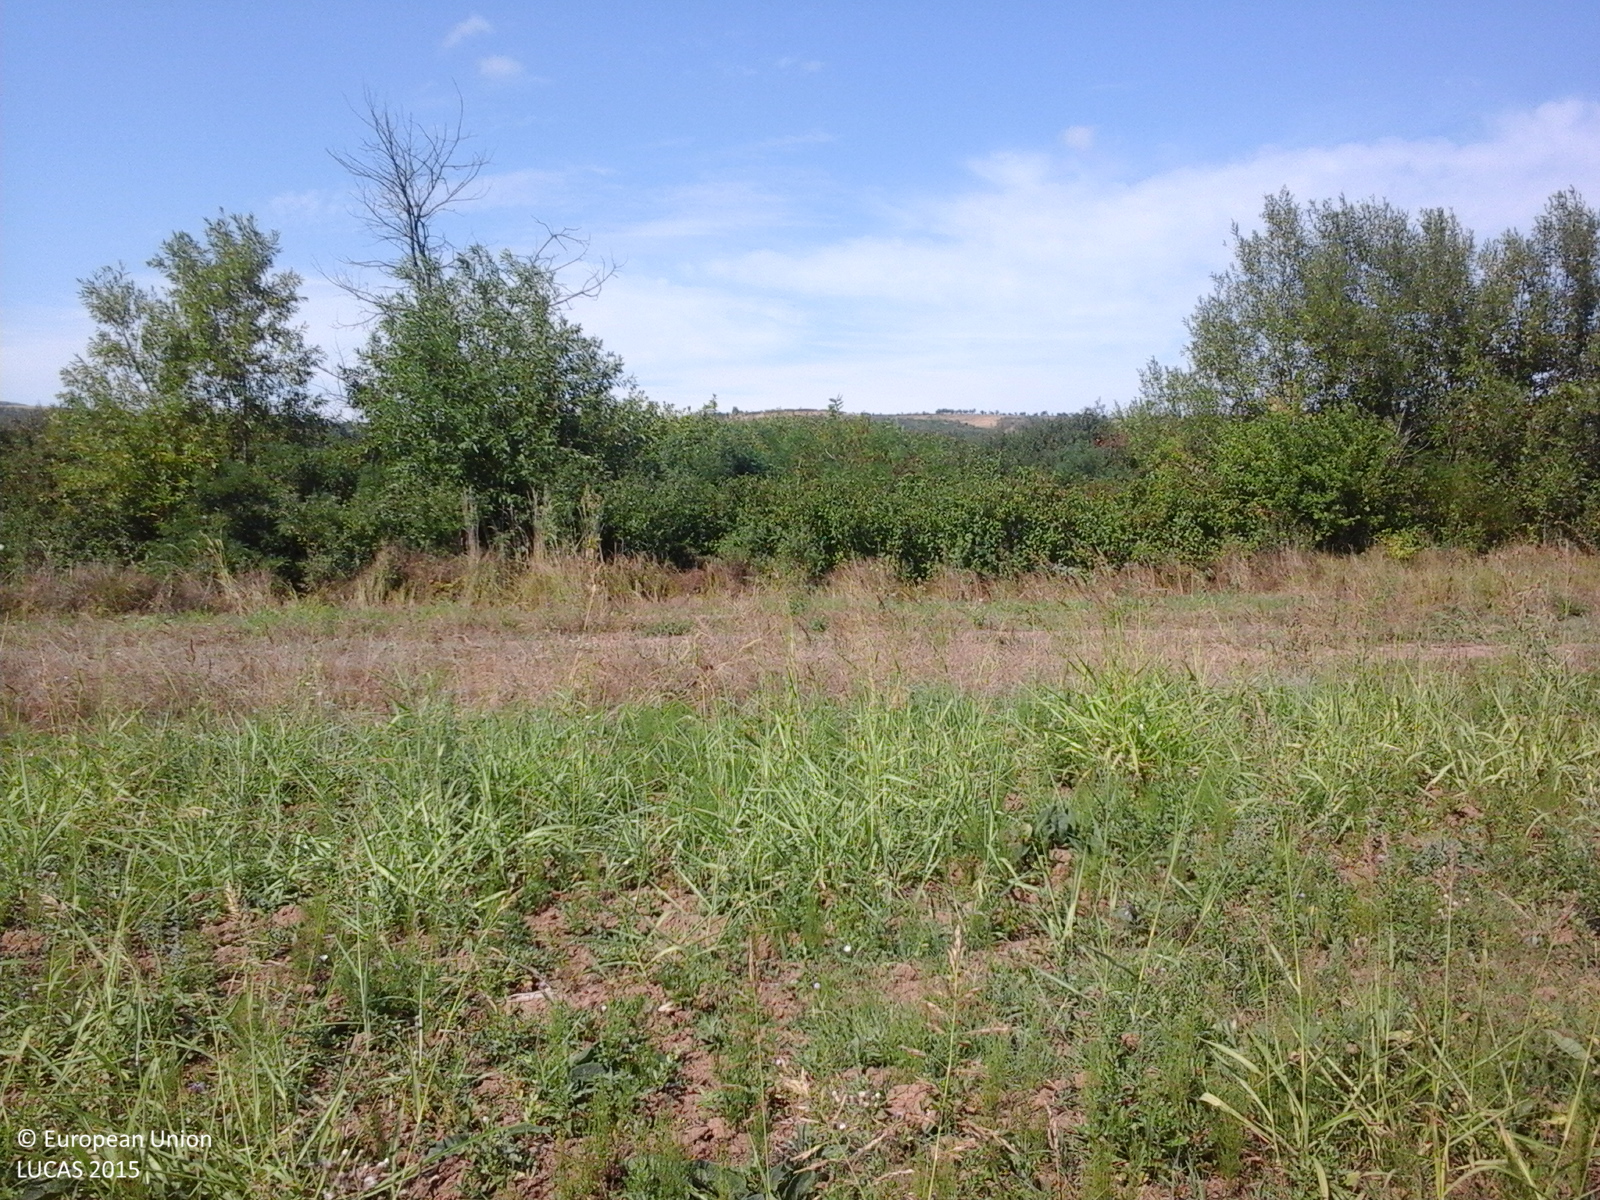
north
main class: Grassland
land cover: Spontaneously vegetated surfaces
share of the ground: > 75 %
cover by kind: herbaceous plants 100 %
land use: Fallow land
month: August
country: RO
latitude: 45.0711
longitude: 21.5249
